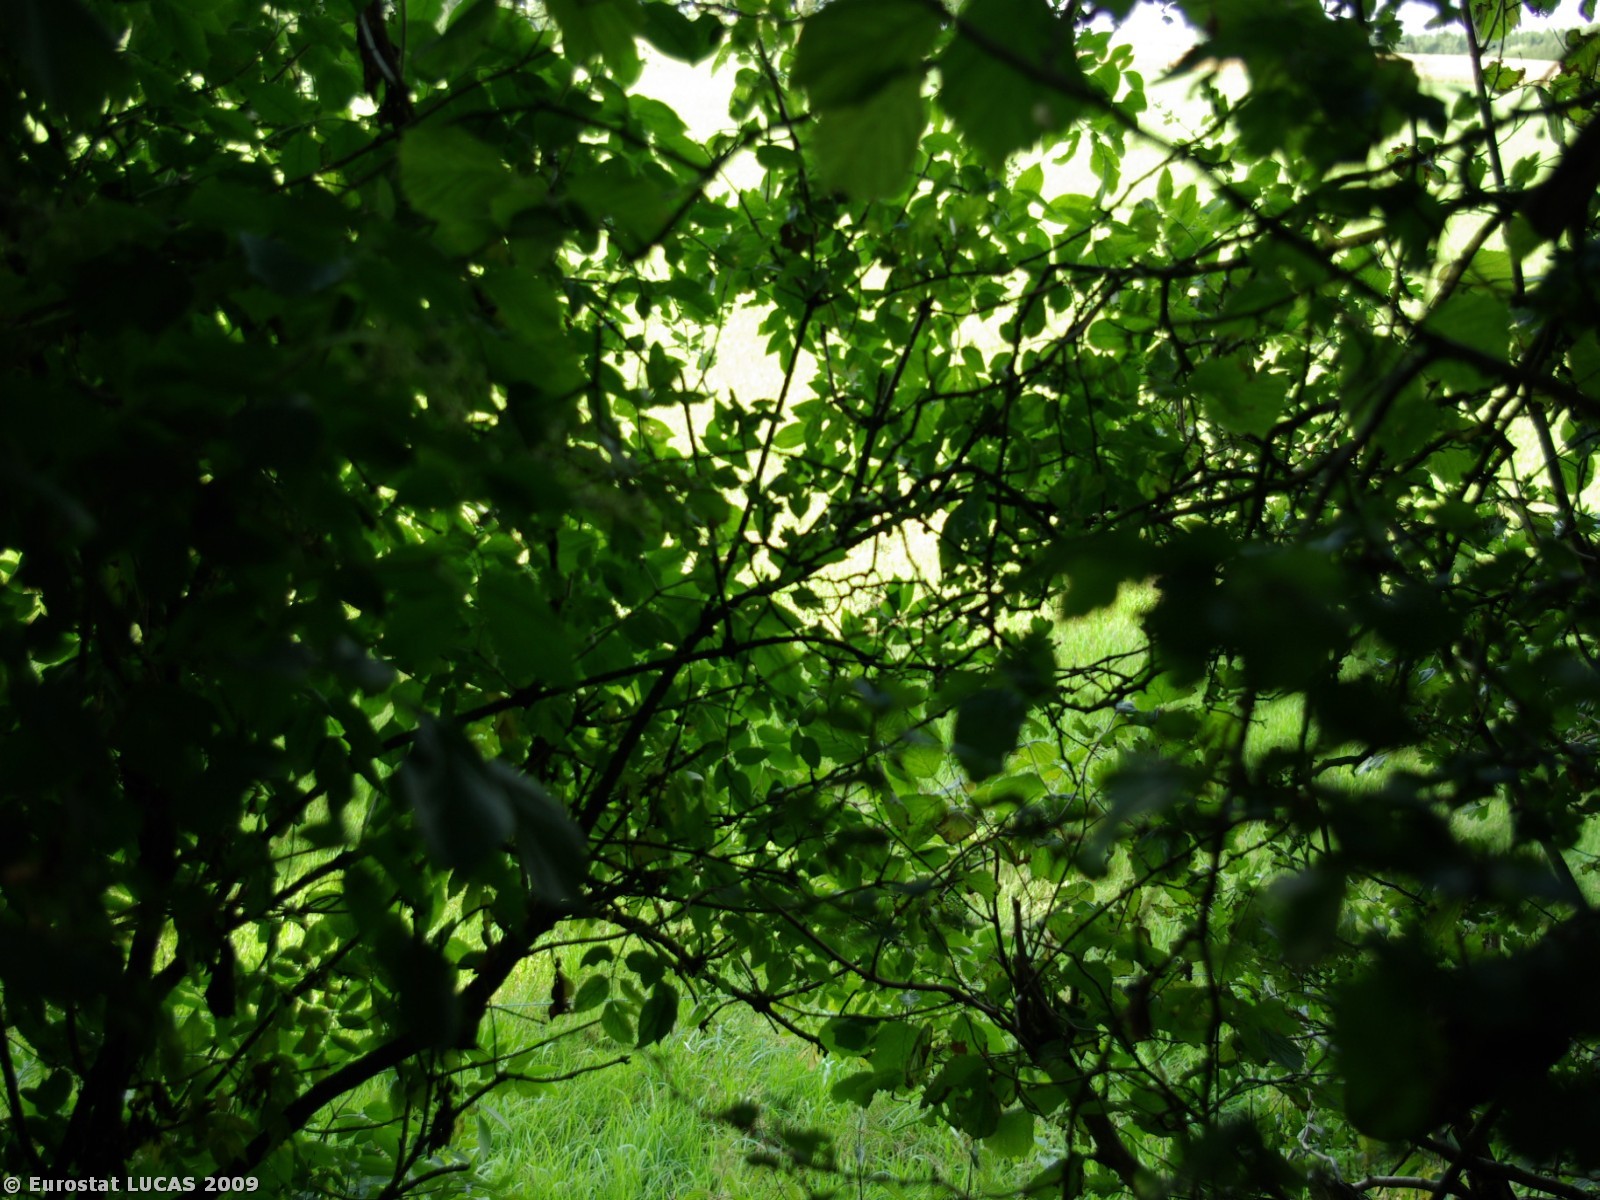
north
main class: Woodland
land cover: Mixed woodland
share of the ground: > 75 %
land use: Unused
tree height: > 5 m
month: July
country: DK
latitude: 54.9815
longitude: 9.2974
